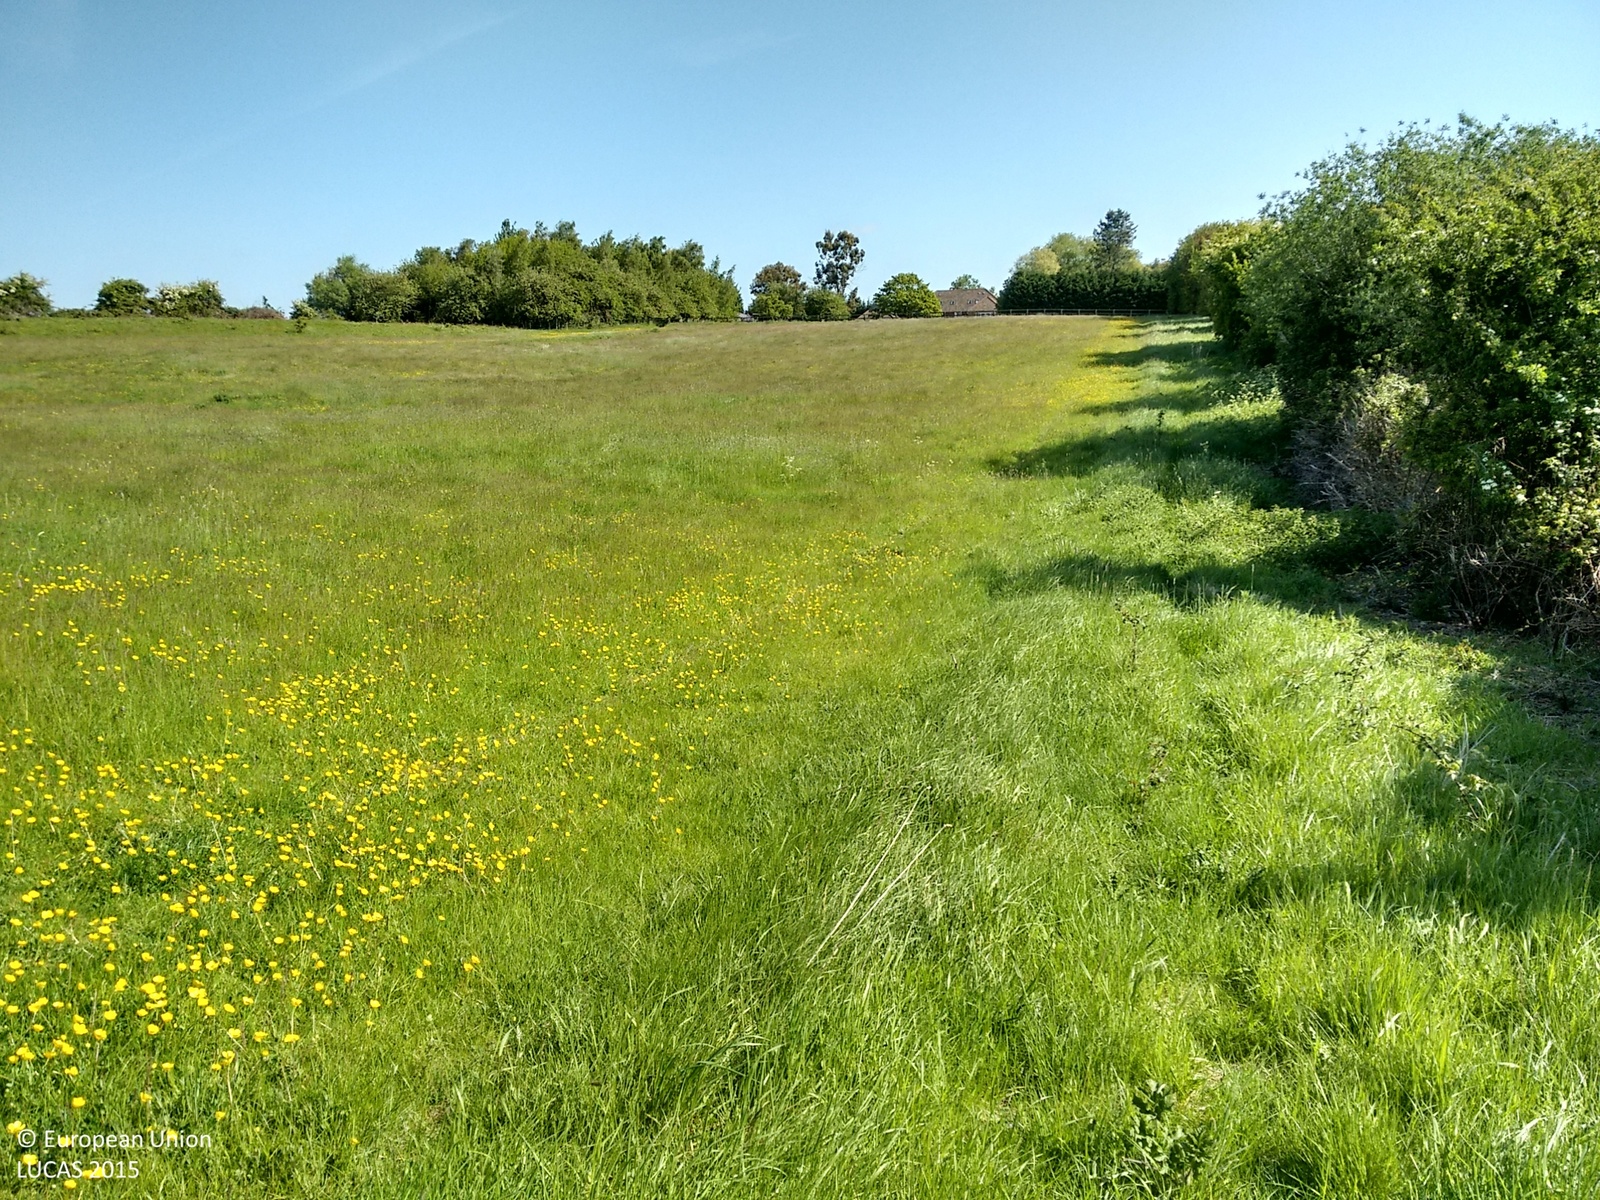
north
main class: Grassland
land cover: Grassland without tree/shrub cover
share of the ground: > 75 %
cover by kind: herbaceous plants 100 %
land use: Agriculture (excluding fallow land and kitchen gardens)
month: May
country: GB
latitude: 52.0408
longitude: -0.4619
